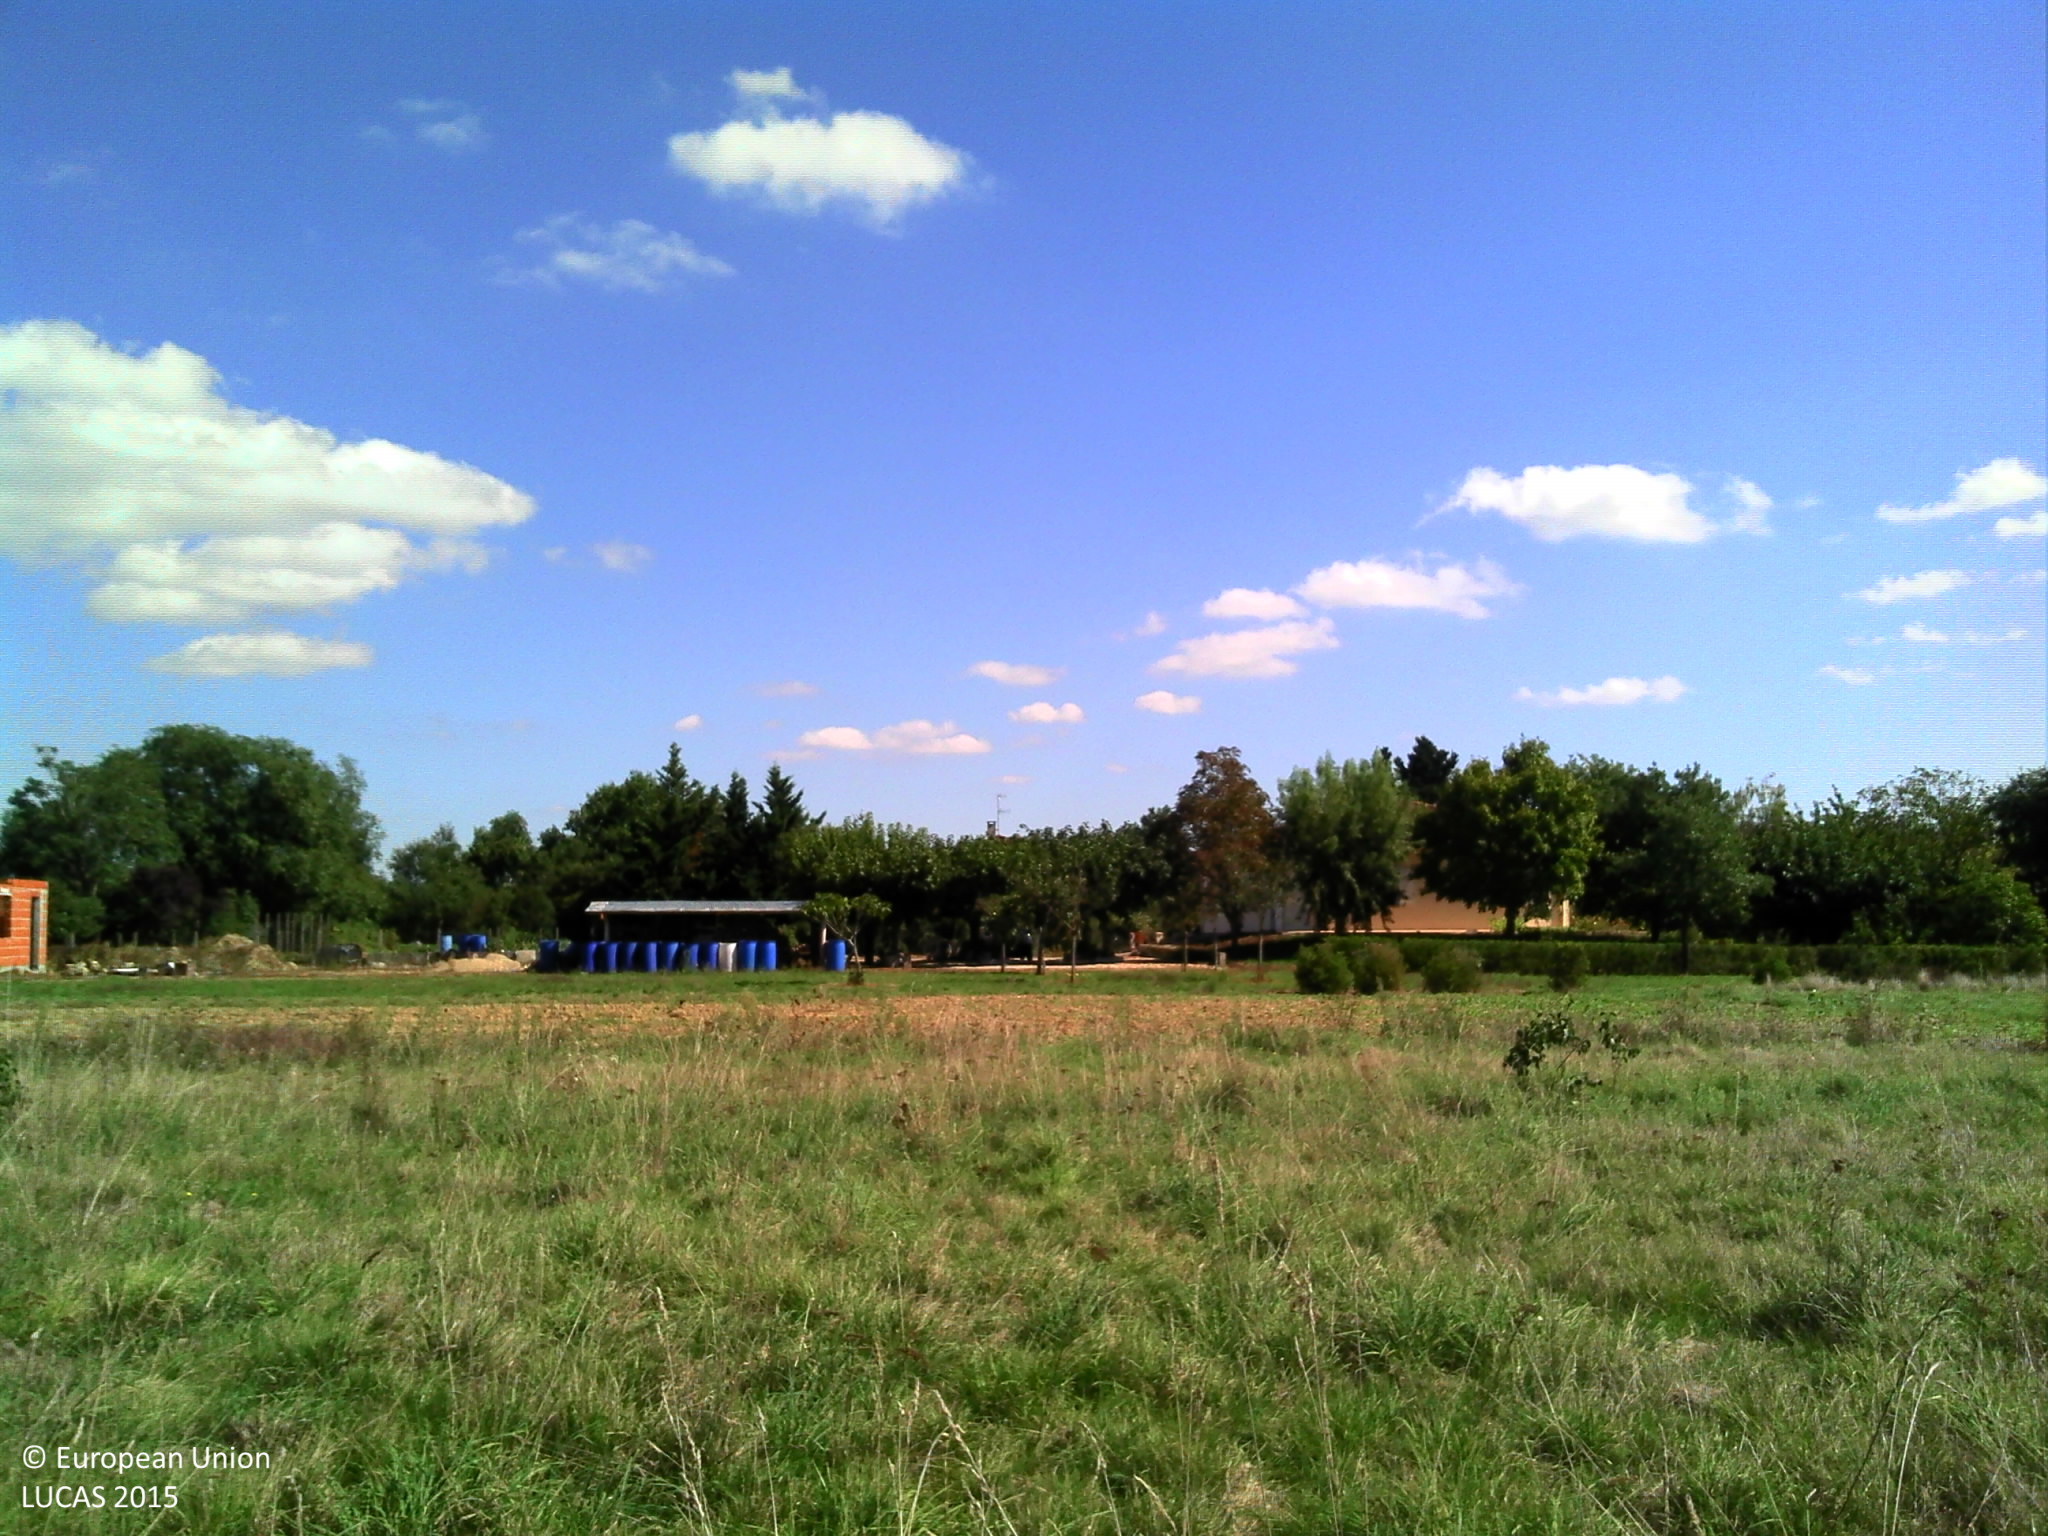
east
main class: Grassland
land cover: Grassland without tree/shrub cover
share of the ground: > 75 %
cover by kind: herbaceous plants 100 %
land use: Agriculture (excluding fallow land and kitchen gardens)
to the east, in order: Grassland without tree/shrub cover; Common wheat; Grassland with sparse tree/shrub cover; Artificial constructions in urban areas
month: September
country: FR
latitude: 43.8738
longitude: 1.2767
